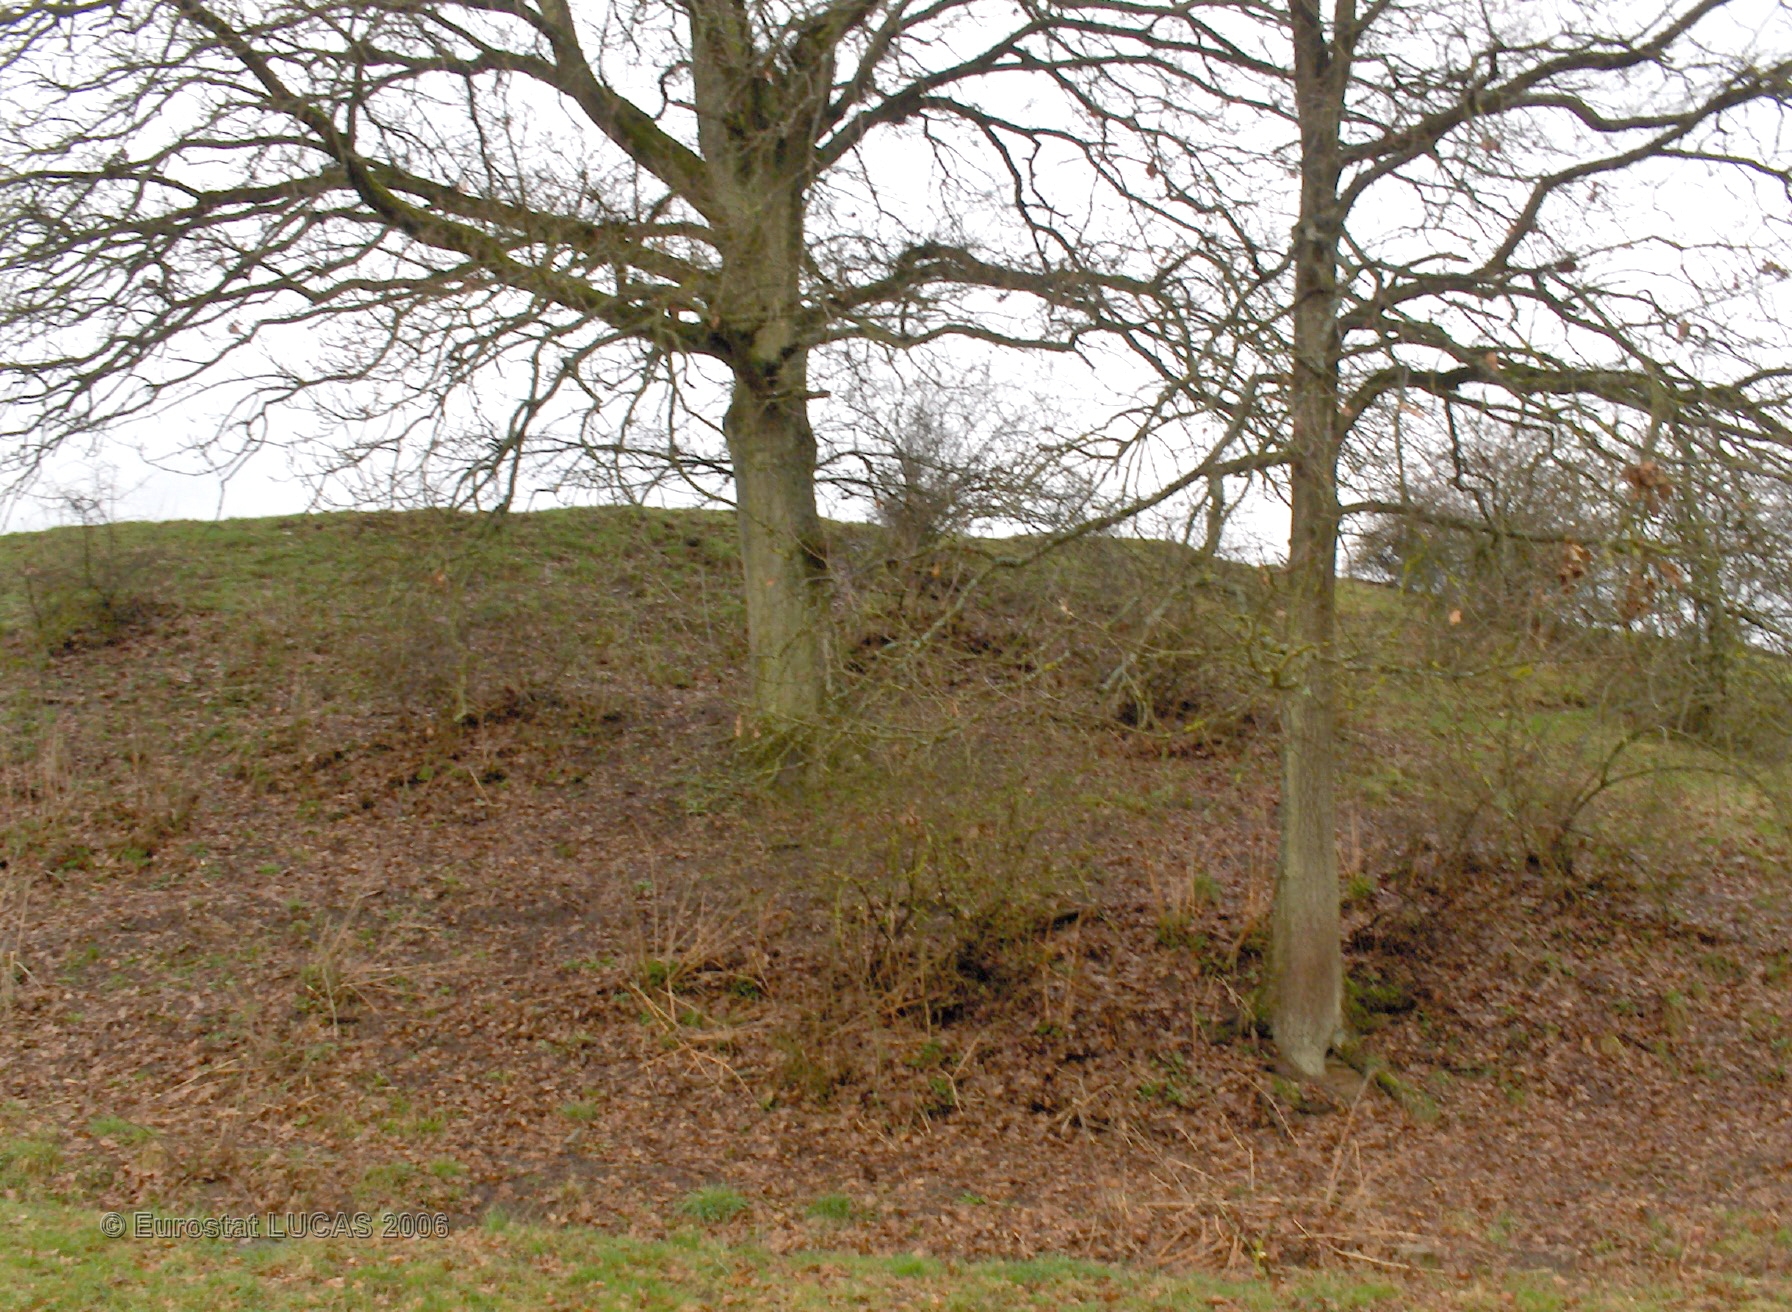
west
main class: Grassland
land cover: Grassland with sparse tree/shrub cover
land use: Agriculture (excluding fallow land and kitchen gardens)
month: April
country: BE
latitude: 50.2125
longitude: 5.2754
